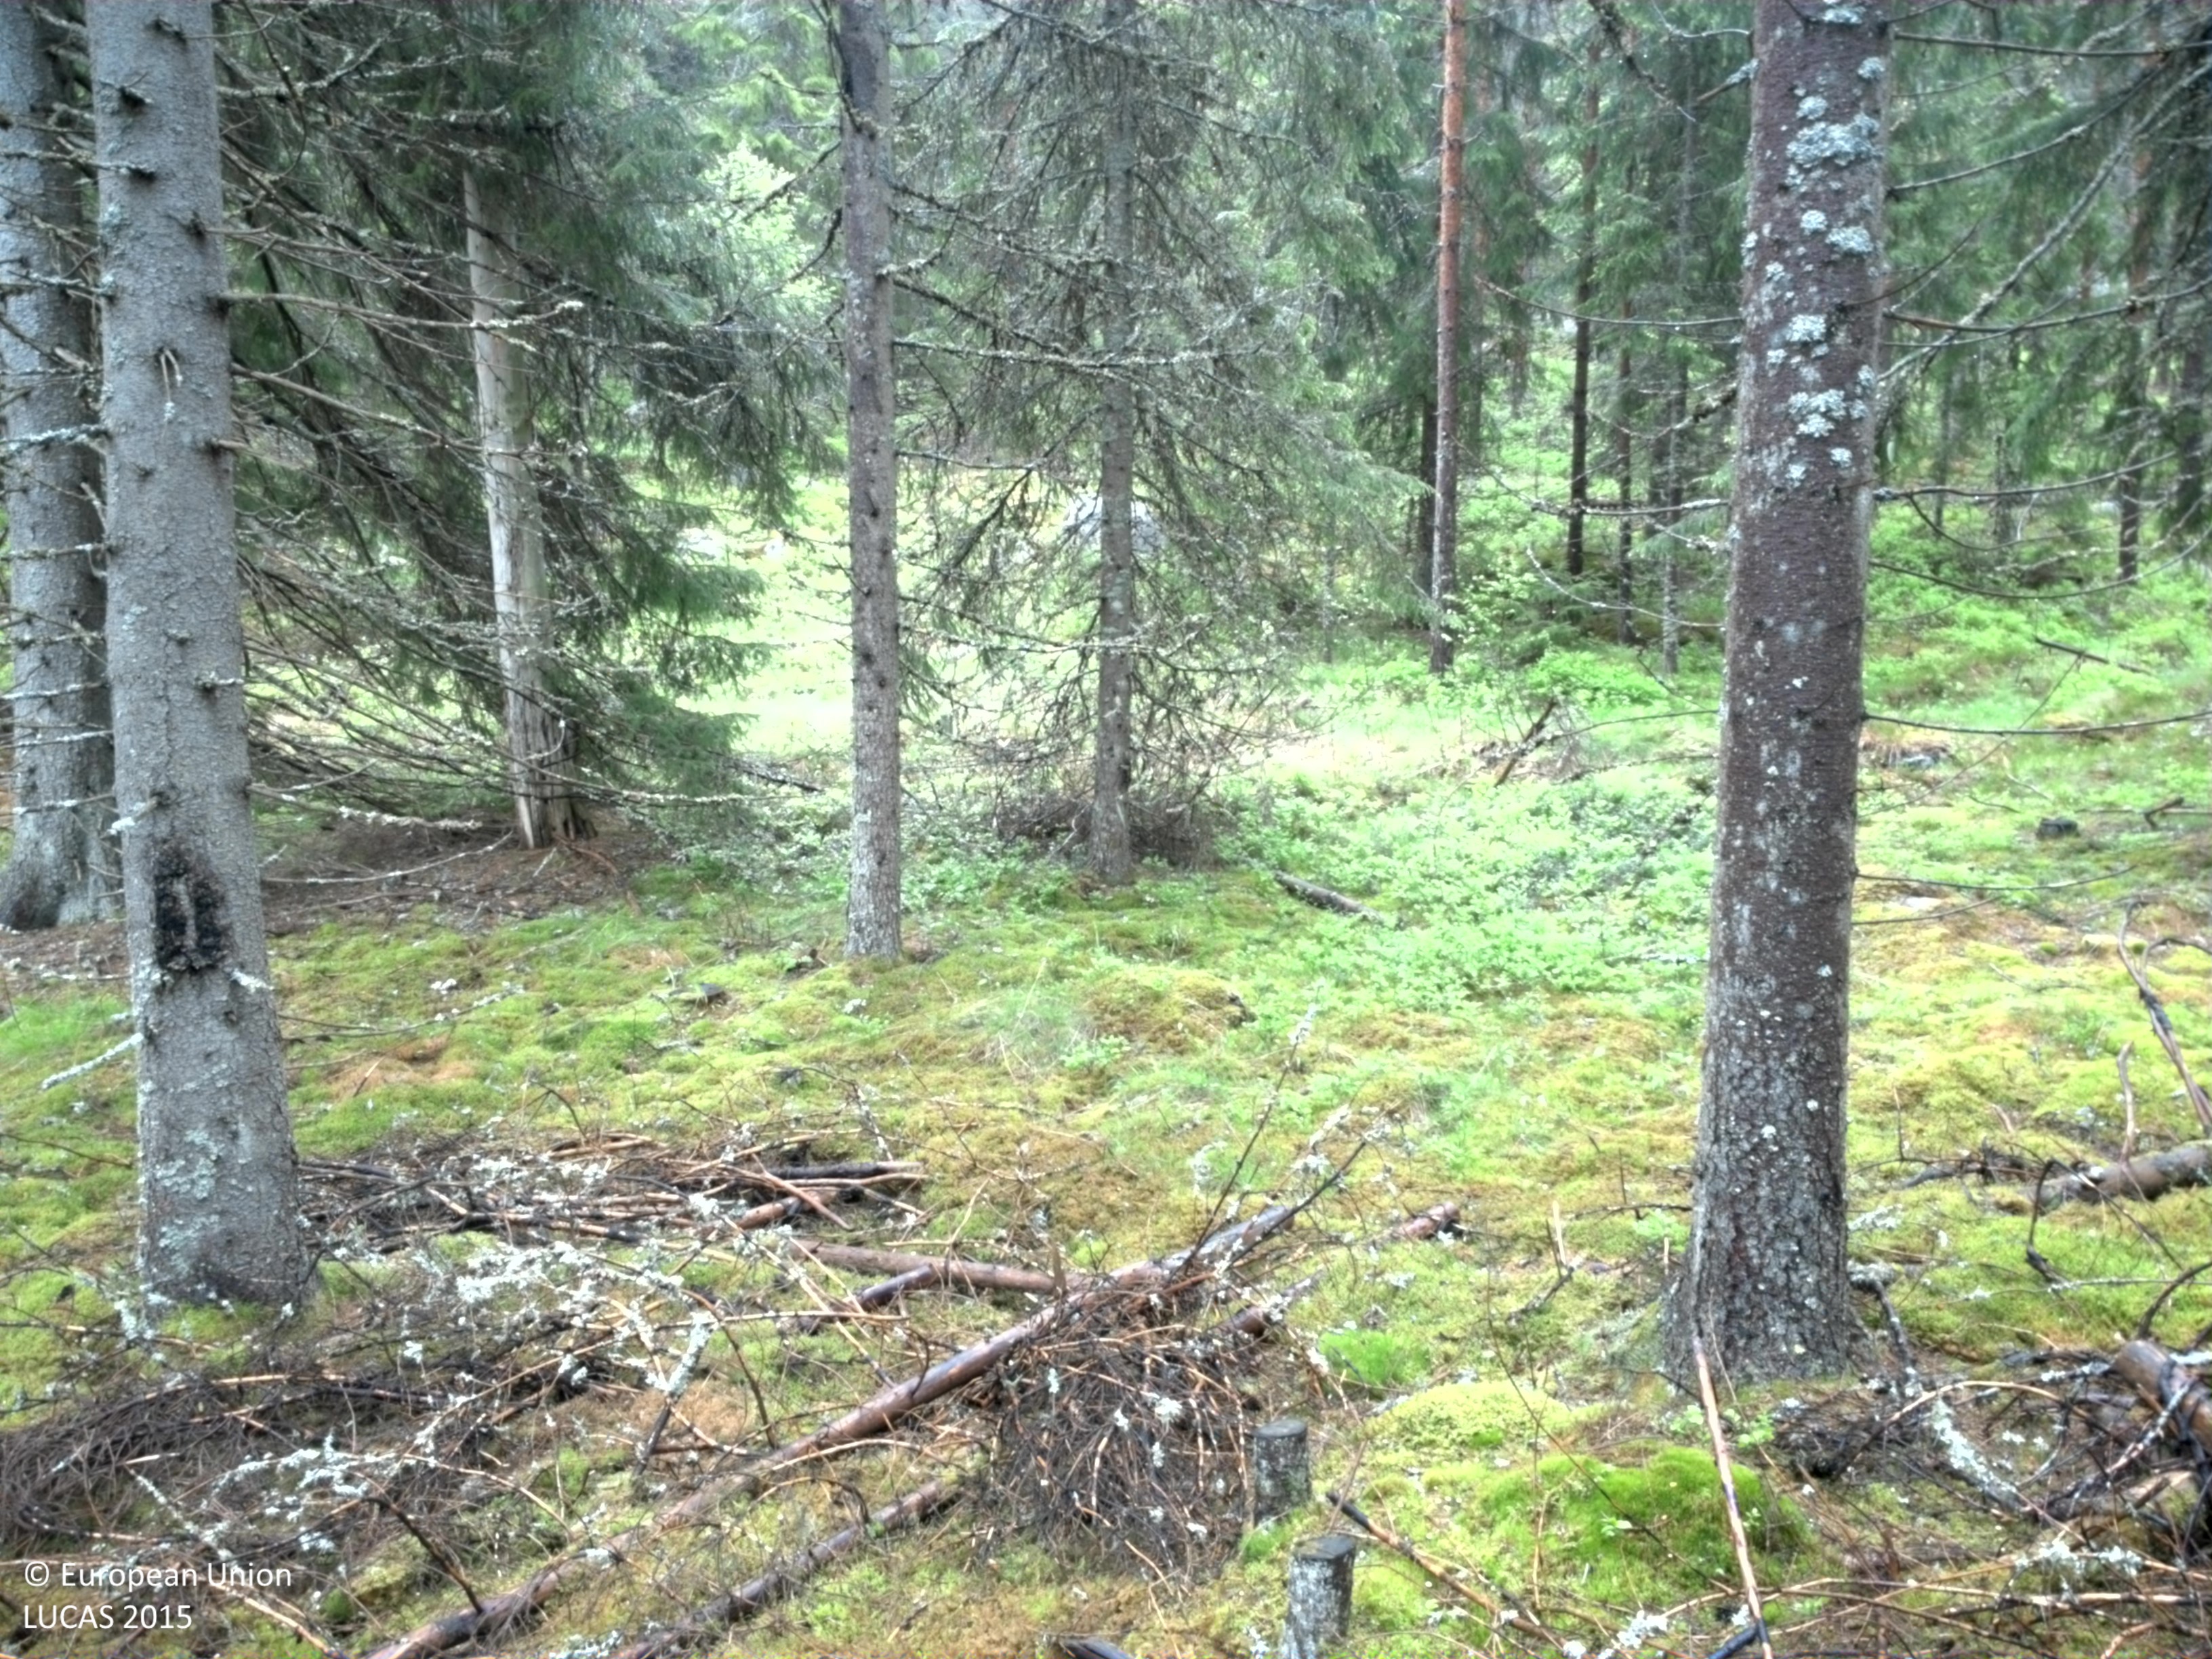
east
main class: Woodland
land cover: Other coniferous woodland
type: boreal forest
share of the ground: 50 - 75 %
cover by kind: coniferous forest trees 70 %, lichens and mosses 15 %, broadleaved forest trees 5 %, shrubs 5 %, herbaceous plants 5 %
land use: Forestry
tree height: > 5 m
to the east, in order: Other coniferous woodland; Tracks; Other coniferous woodland; Other mixed woodland; Pine dominated mixed woodland; Tracks; Pine dominated mixed woodland; Other mixed woodland; Pine dominated mixed woodland
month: May
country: SE
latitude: 59.4542
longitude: 14.1015
